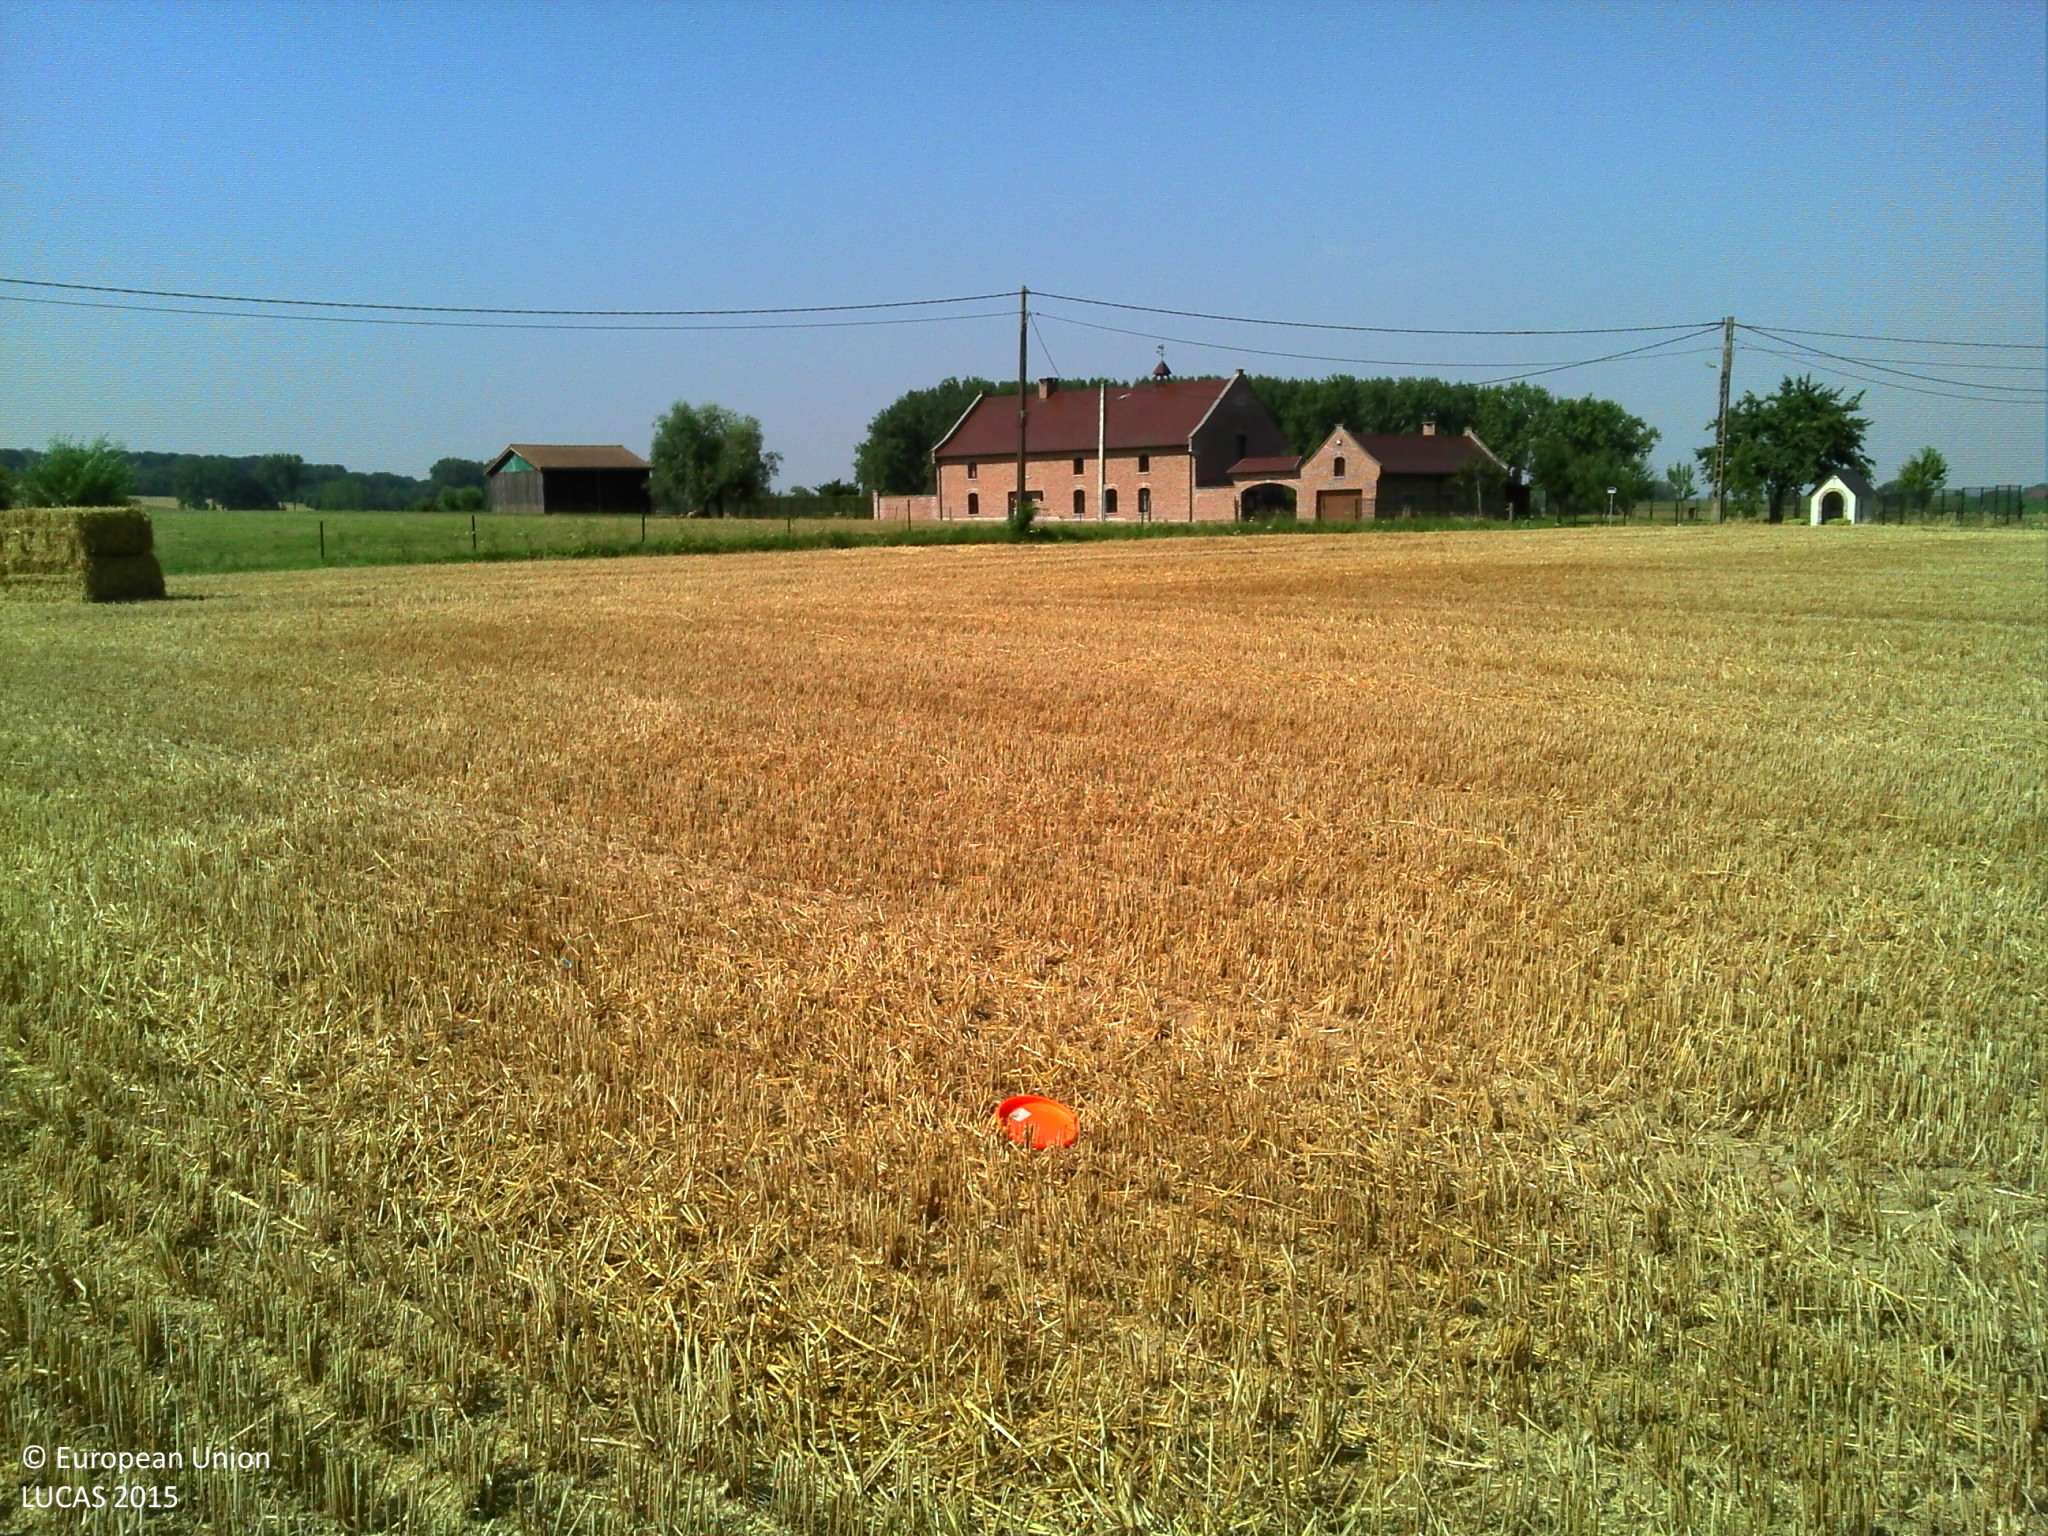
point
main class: Cropland
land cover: Common wheat
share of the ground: < 10 %
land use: Agriculture (excluding fallow land and kitchen gardens)
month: August
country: BE
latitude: 50.6564
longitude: 3.9824
